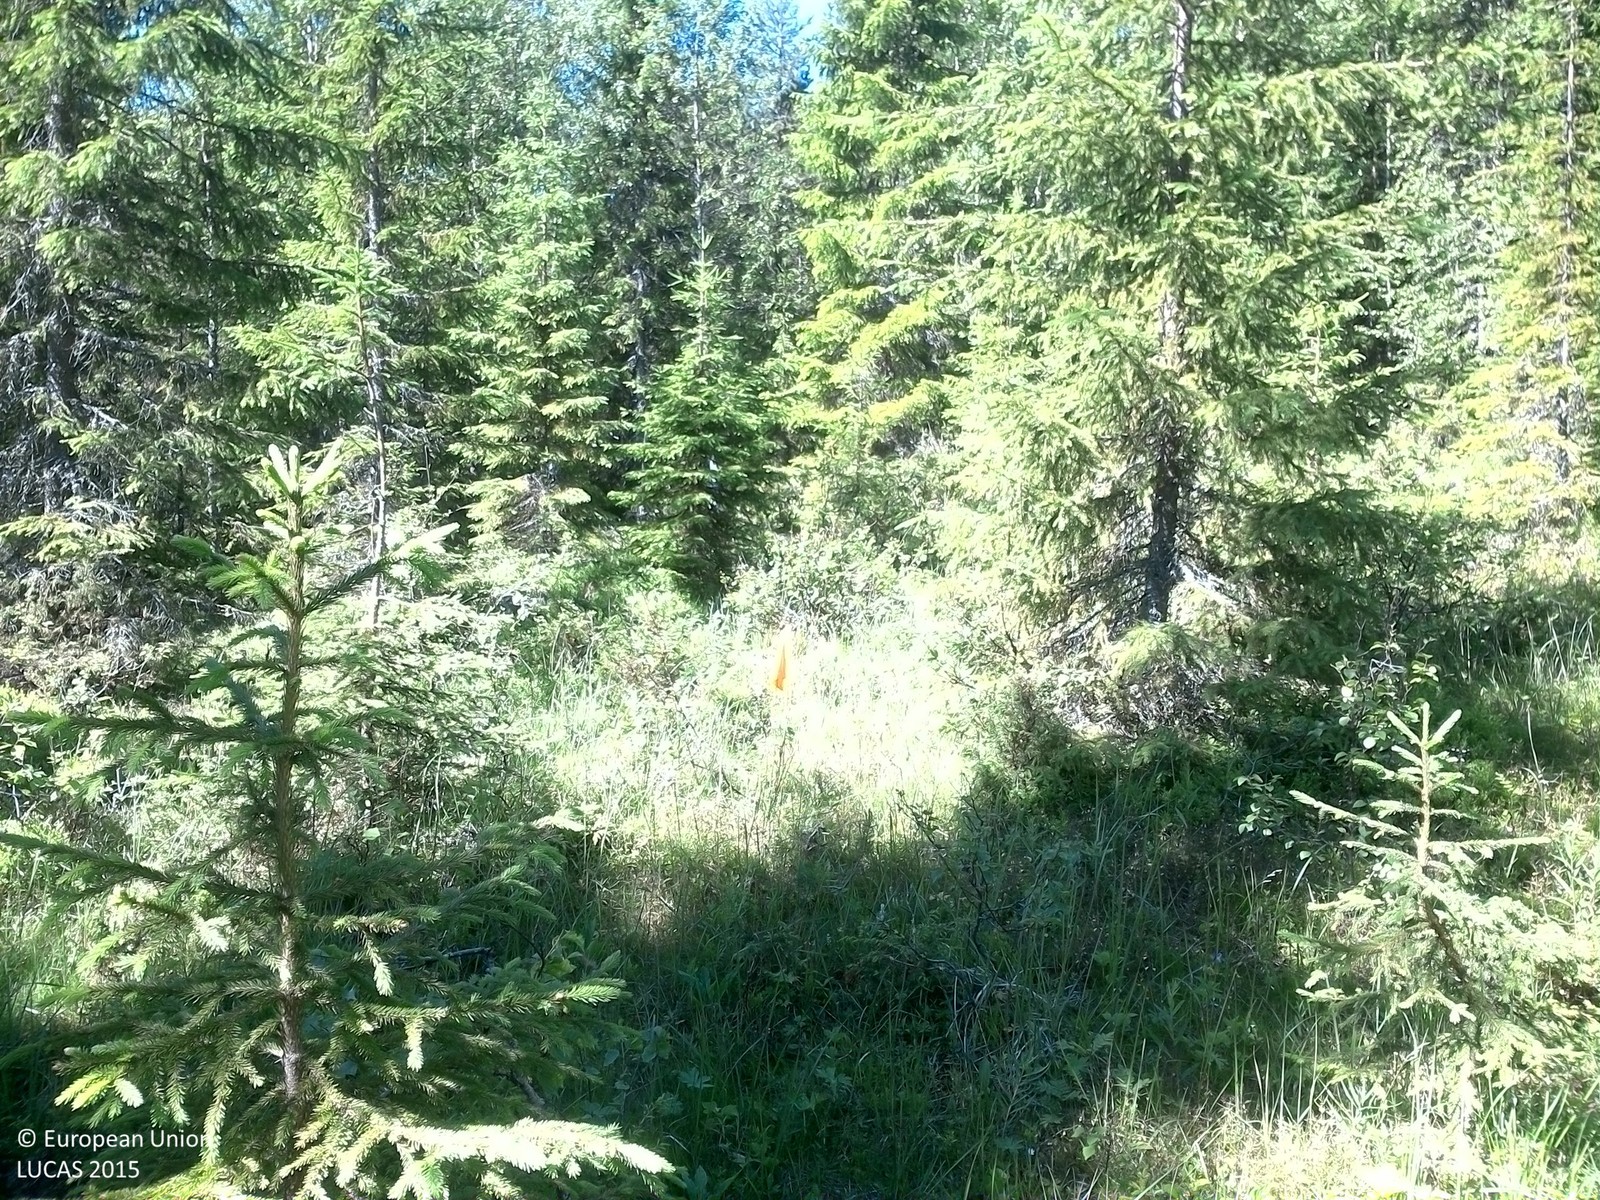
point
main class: Woodland
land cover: Spruce dominated coniferous woodland
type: boreal forest
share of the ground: 25 - 50 %
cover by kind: coniferous forest trees 40 %, herbaceous plants 30 %, shrubs 15 %, lichens and mosses 10 %, broadleaved forest trees 5 %
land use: Forestry
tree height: > 5 m
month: July
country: SE
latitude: 62.8007
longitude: 17.6069
